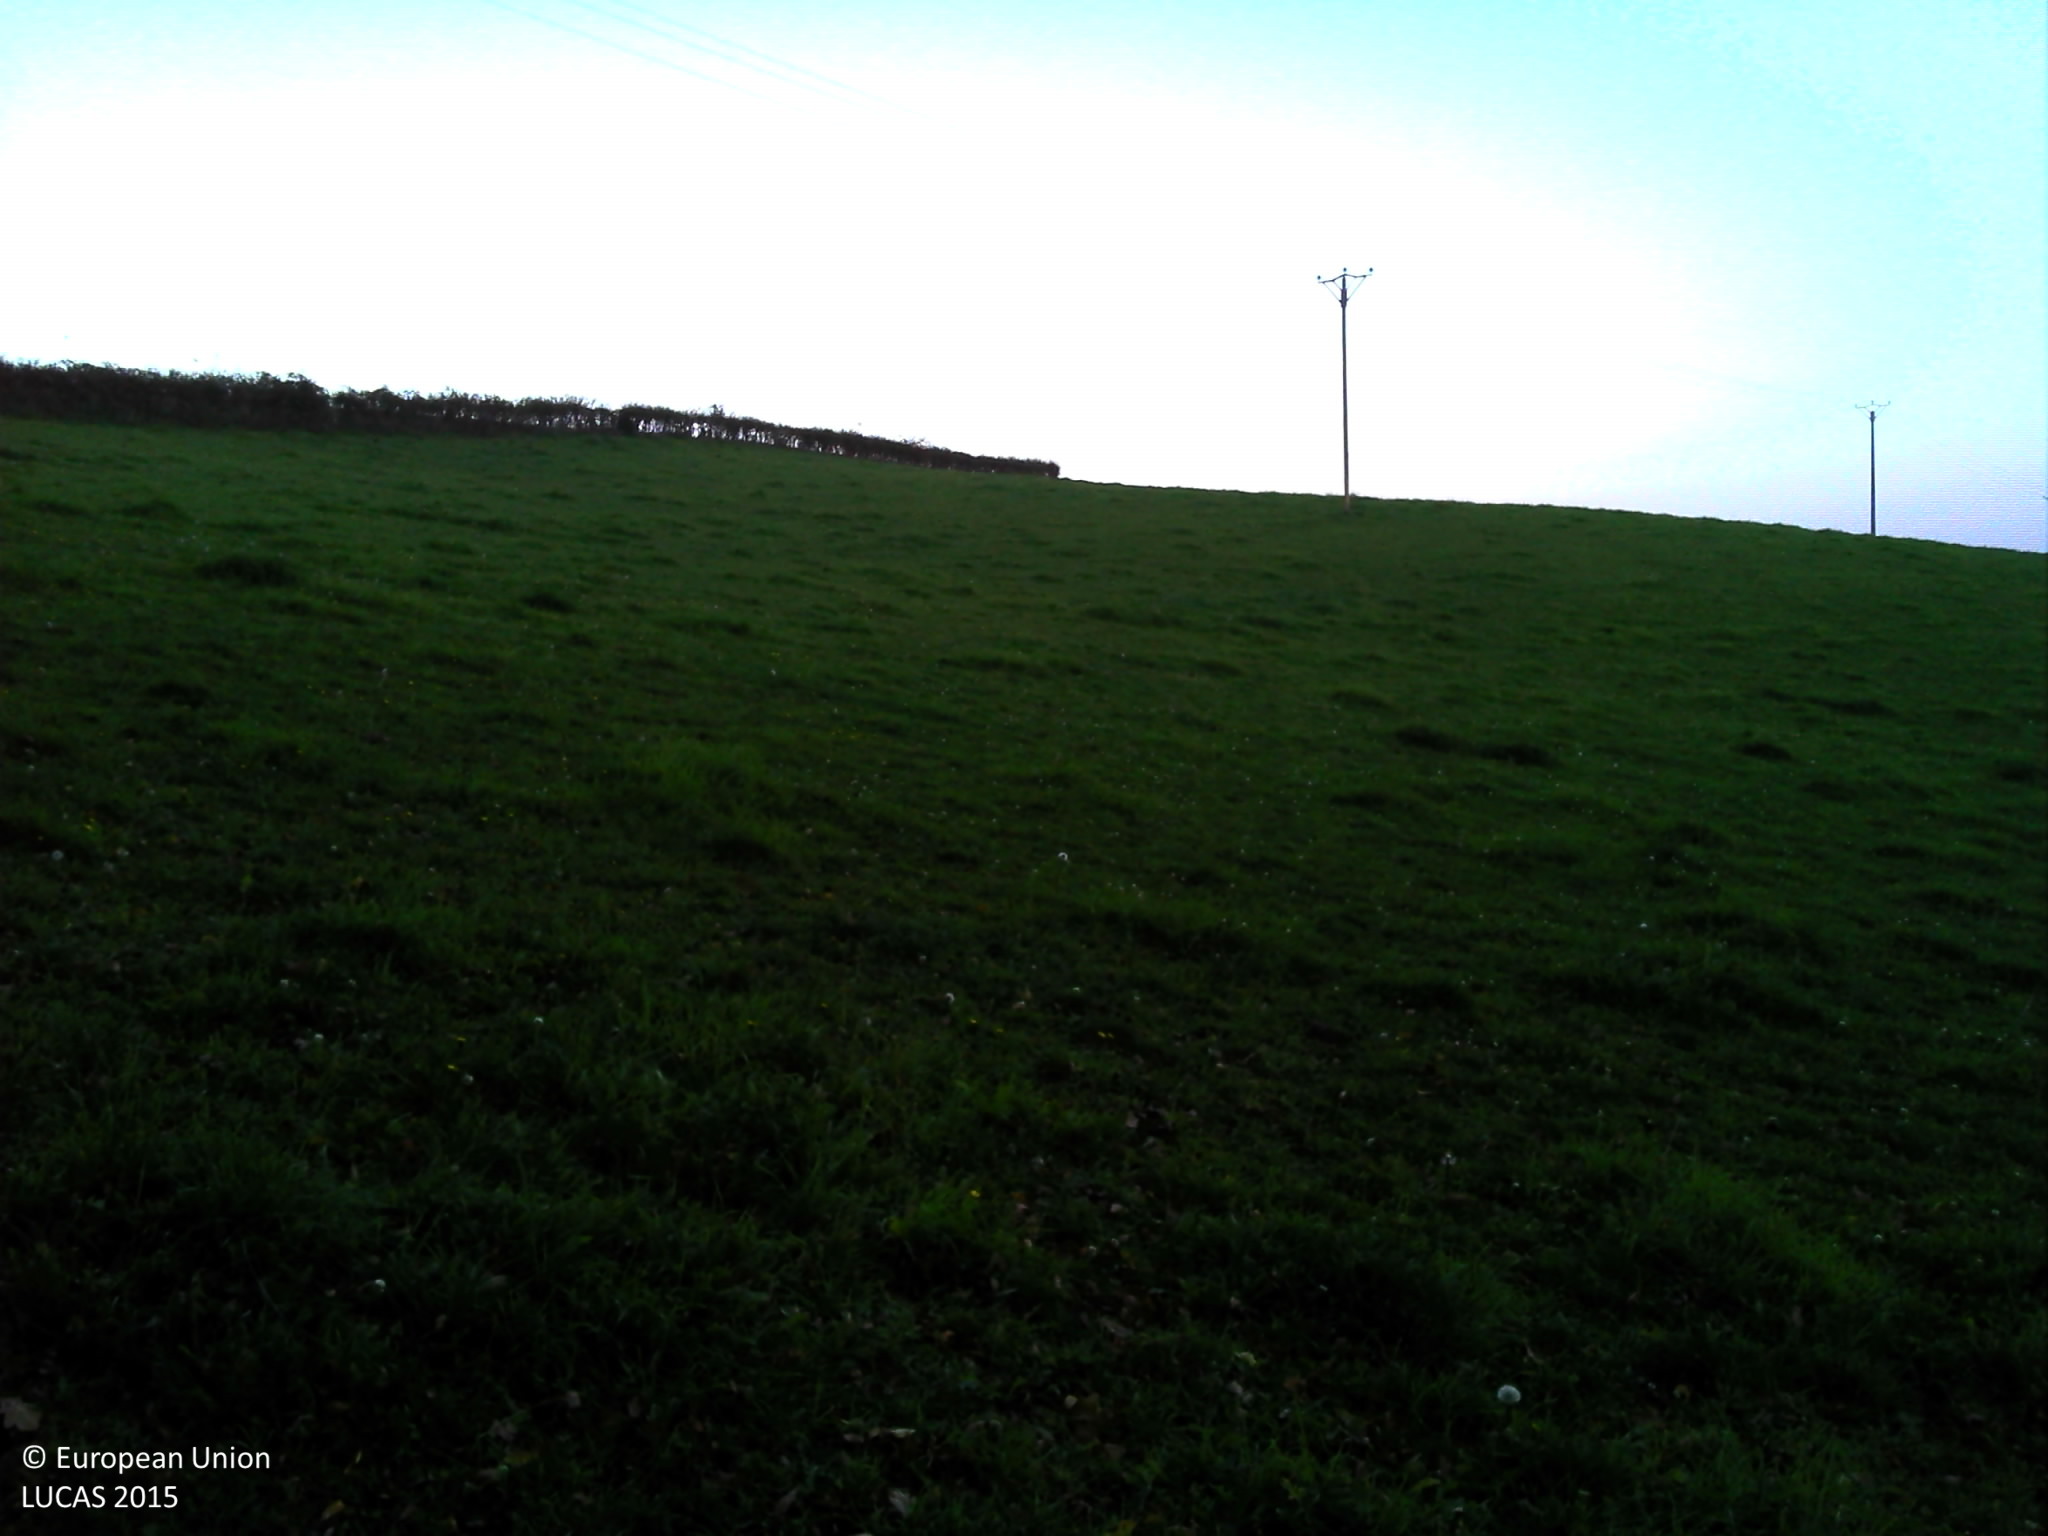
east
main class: Grassland
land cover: Grassland without tree/shrub cover
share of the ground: > 75 %
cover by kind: herbaceous plants 100 %
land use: Agriculture (excluding fallow land and kitchen gardens)
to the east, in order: Grassland without tree/shrub cover; Electric lines; Grassland without tree/shrub cover; Fences; Managed hedges; Temporary grasslands; Fences; Grass margins; Tracks; Grassland without tree/shrub cover
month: October
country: FR
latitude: 46.0703
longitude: 2.7704
